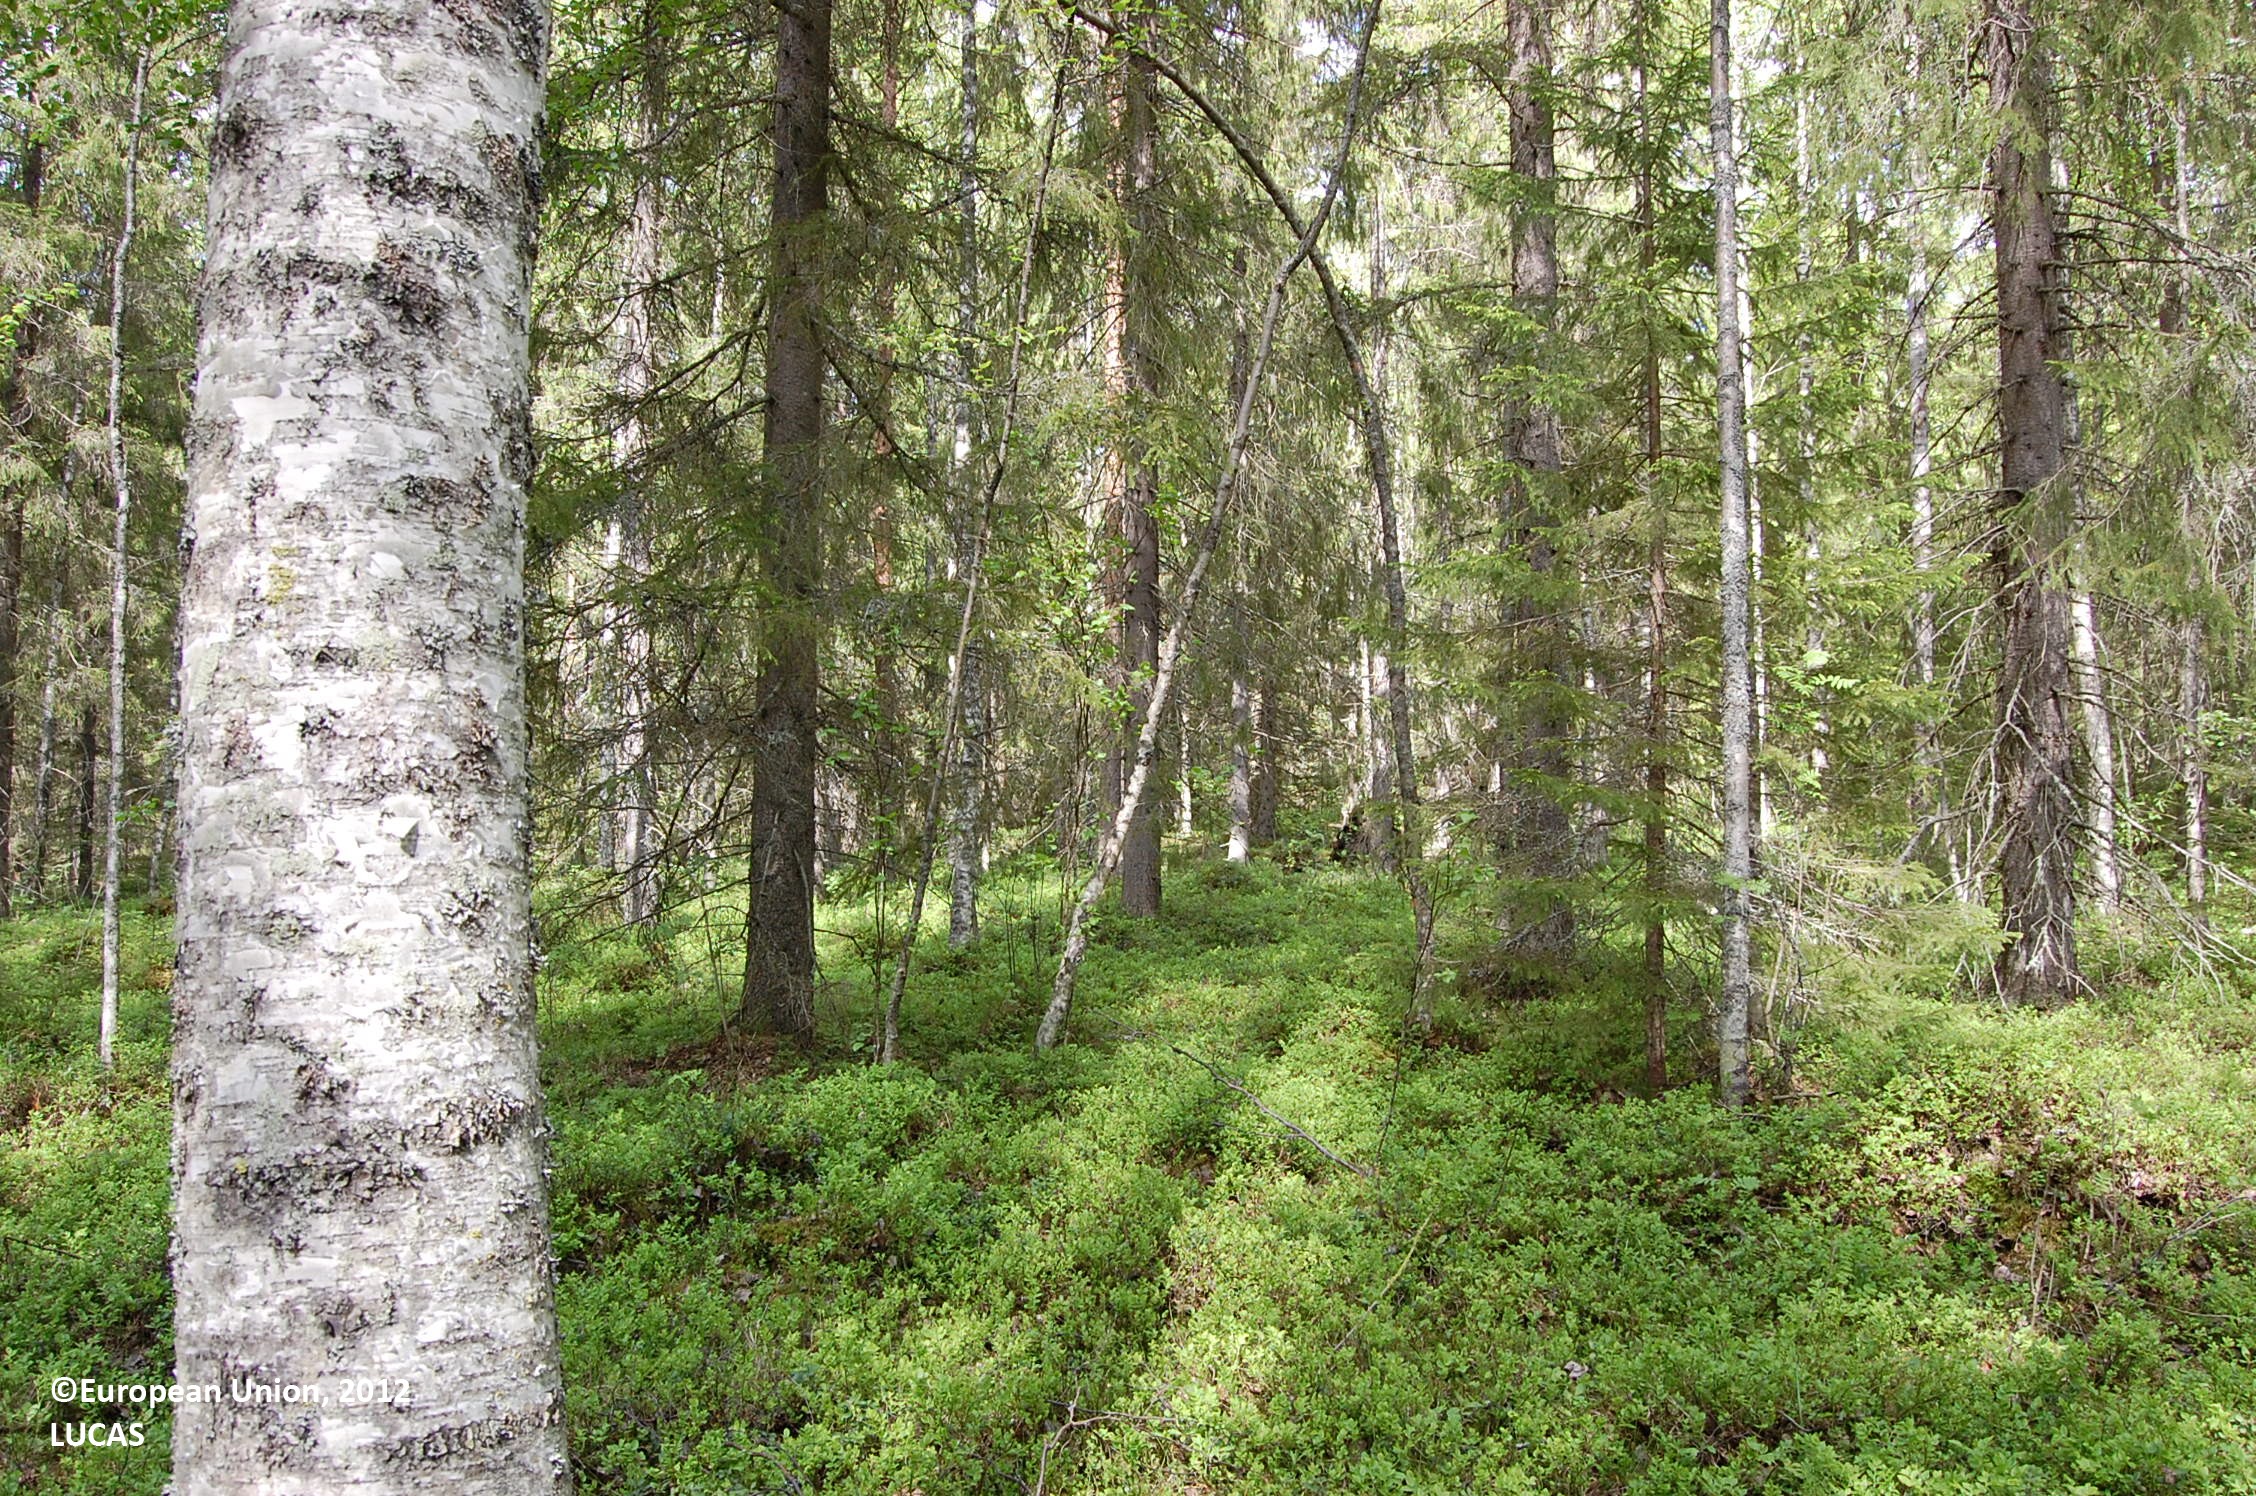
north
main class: Woodland
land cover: Spruce dominated mixed woodland
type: hemiboreal forest and nemoral coniferous forest and mixed broadleaved-coniferous forest
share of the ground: 50 - 75 %
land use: Forestry
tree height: > 5 m
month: June
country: FI
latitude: 64.0579
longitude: 26.1953
